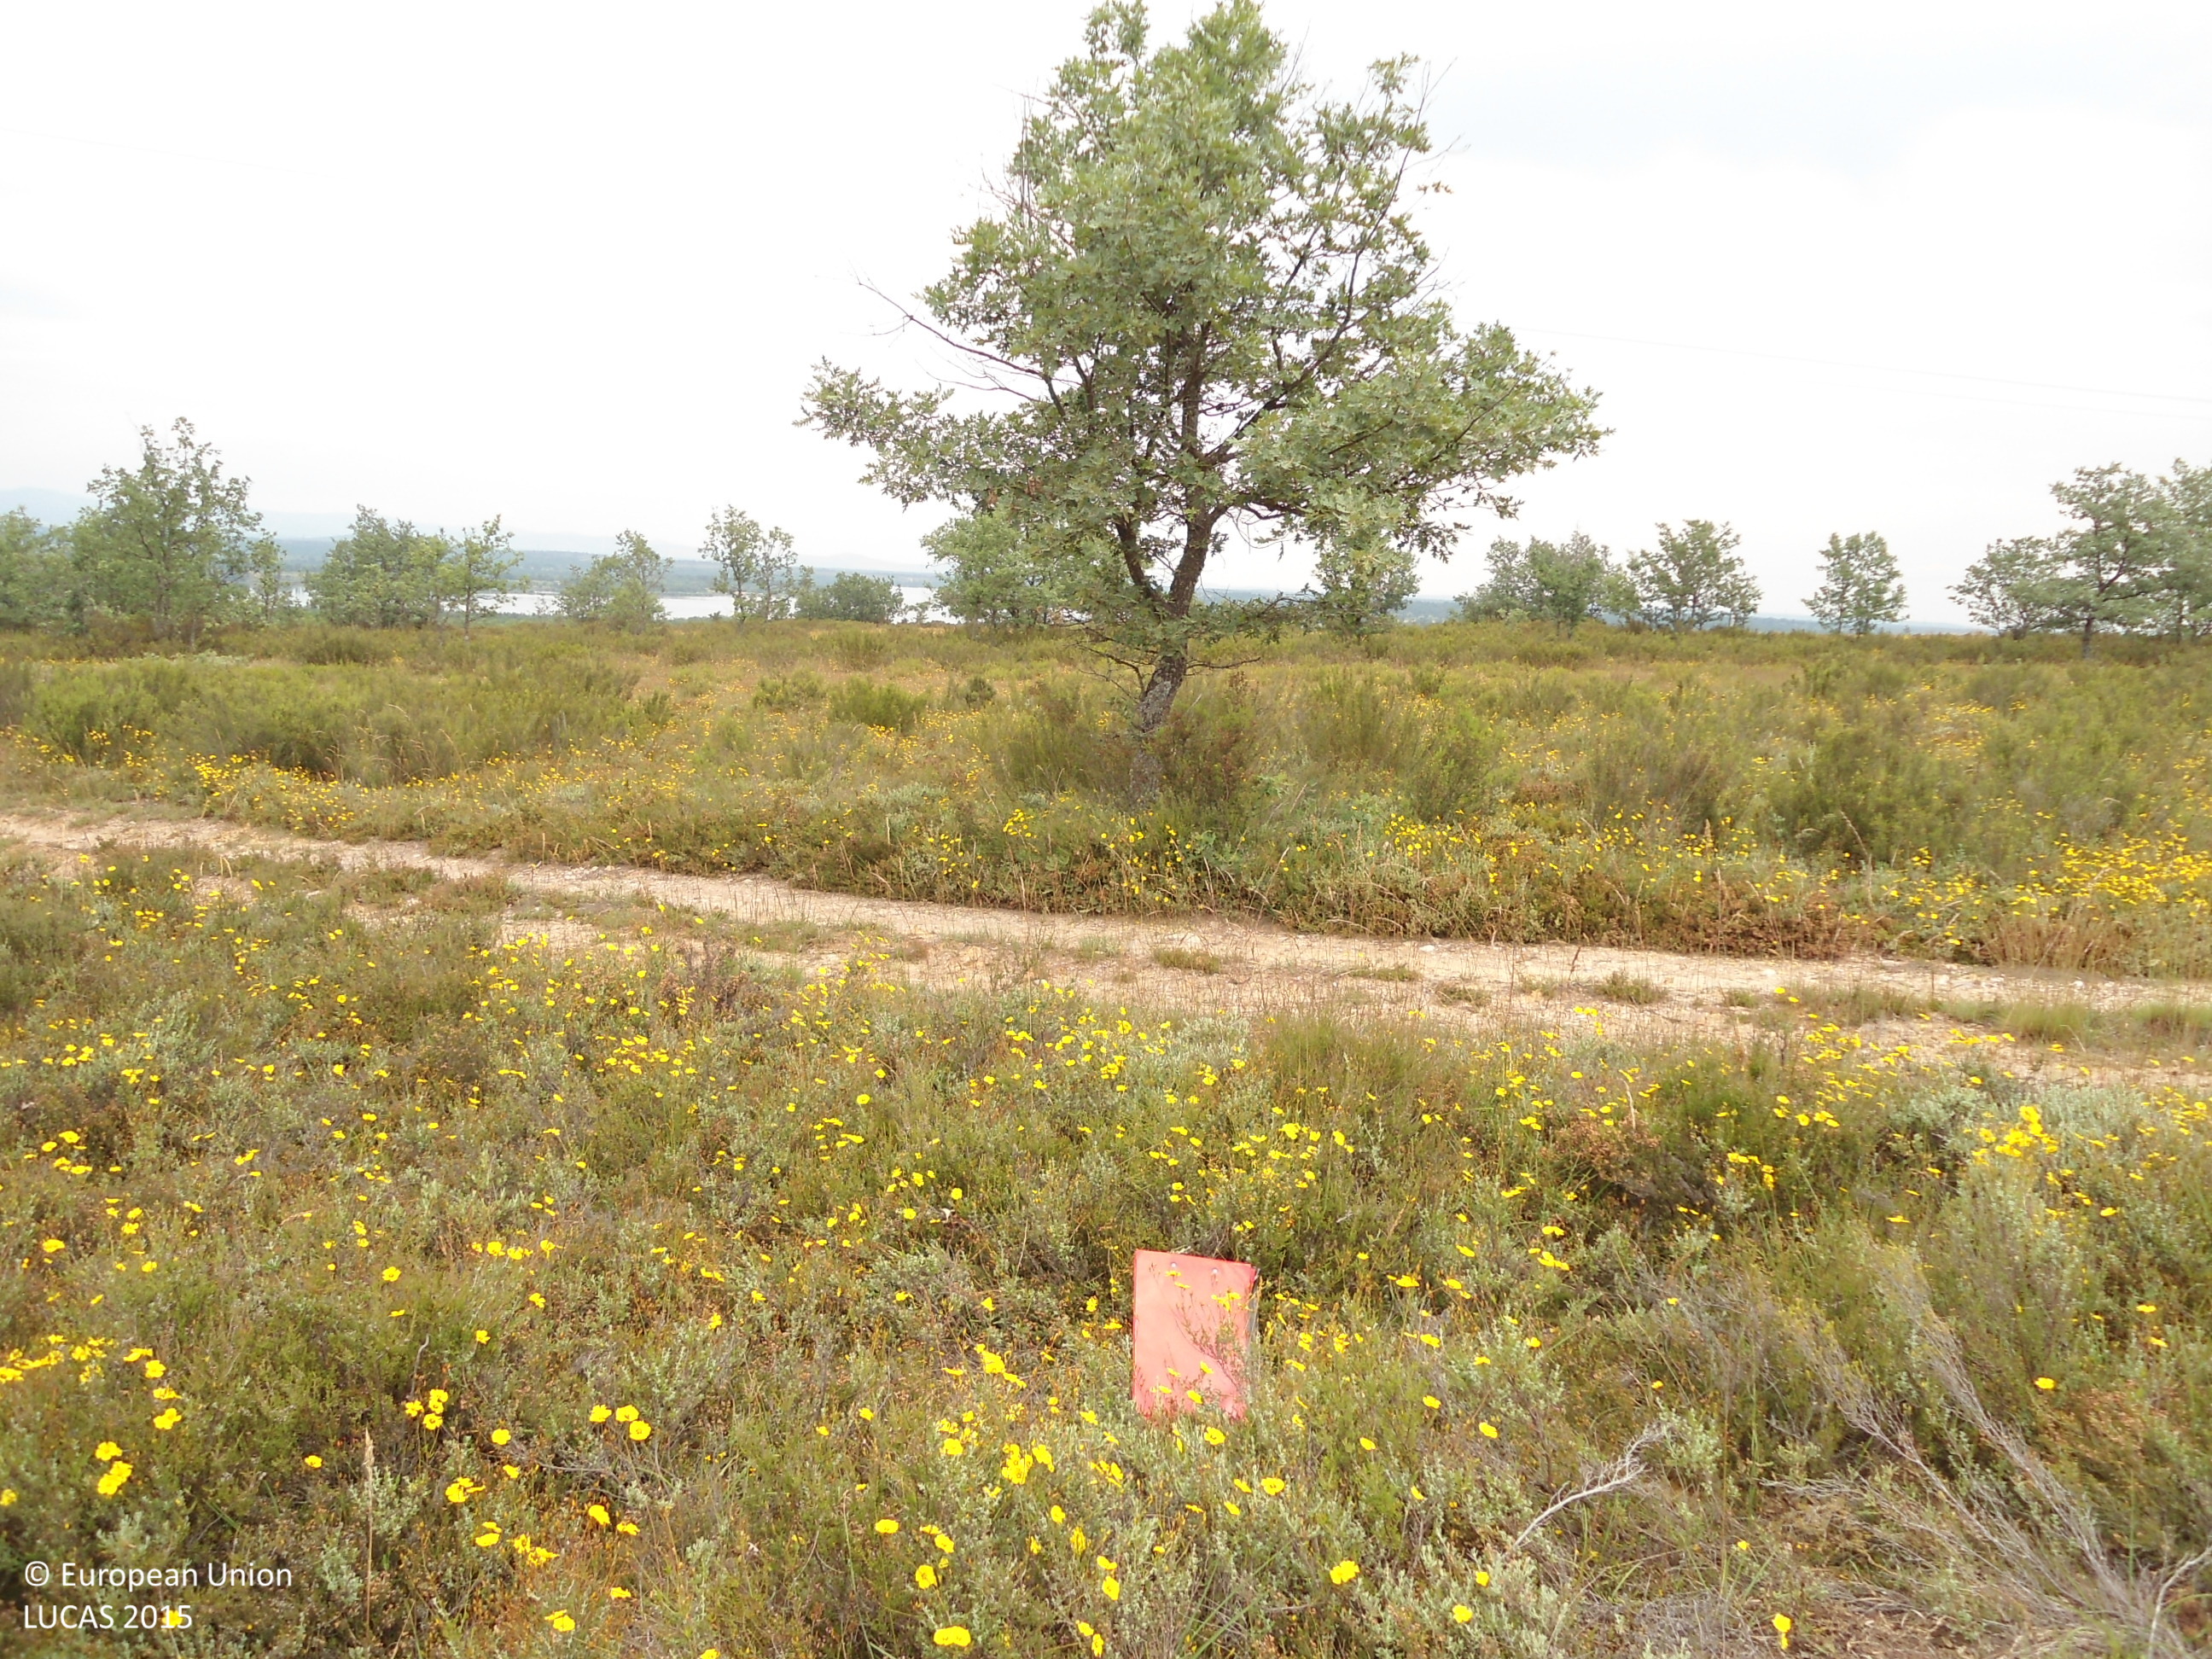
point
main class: Shrubland
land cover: Shrubland with sparse tree cover
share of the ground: > 75 %
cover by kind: shrubs 95 %, broadleaved forest trees 5 %
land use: Semi-natural and natural areas not in use
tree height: < 5 m
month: June
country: ES
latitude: 41.9475
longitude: -6.3051
